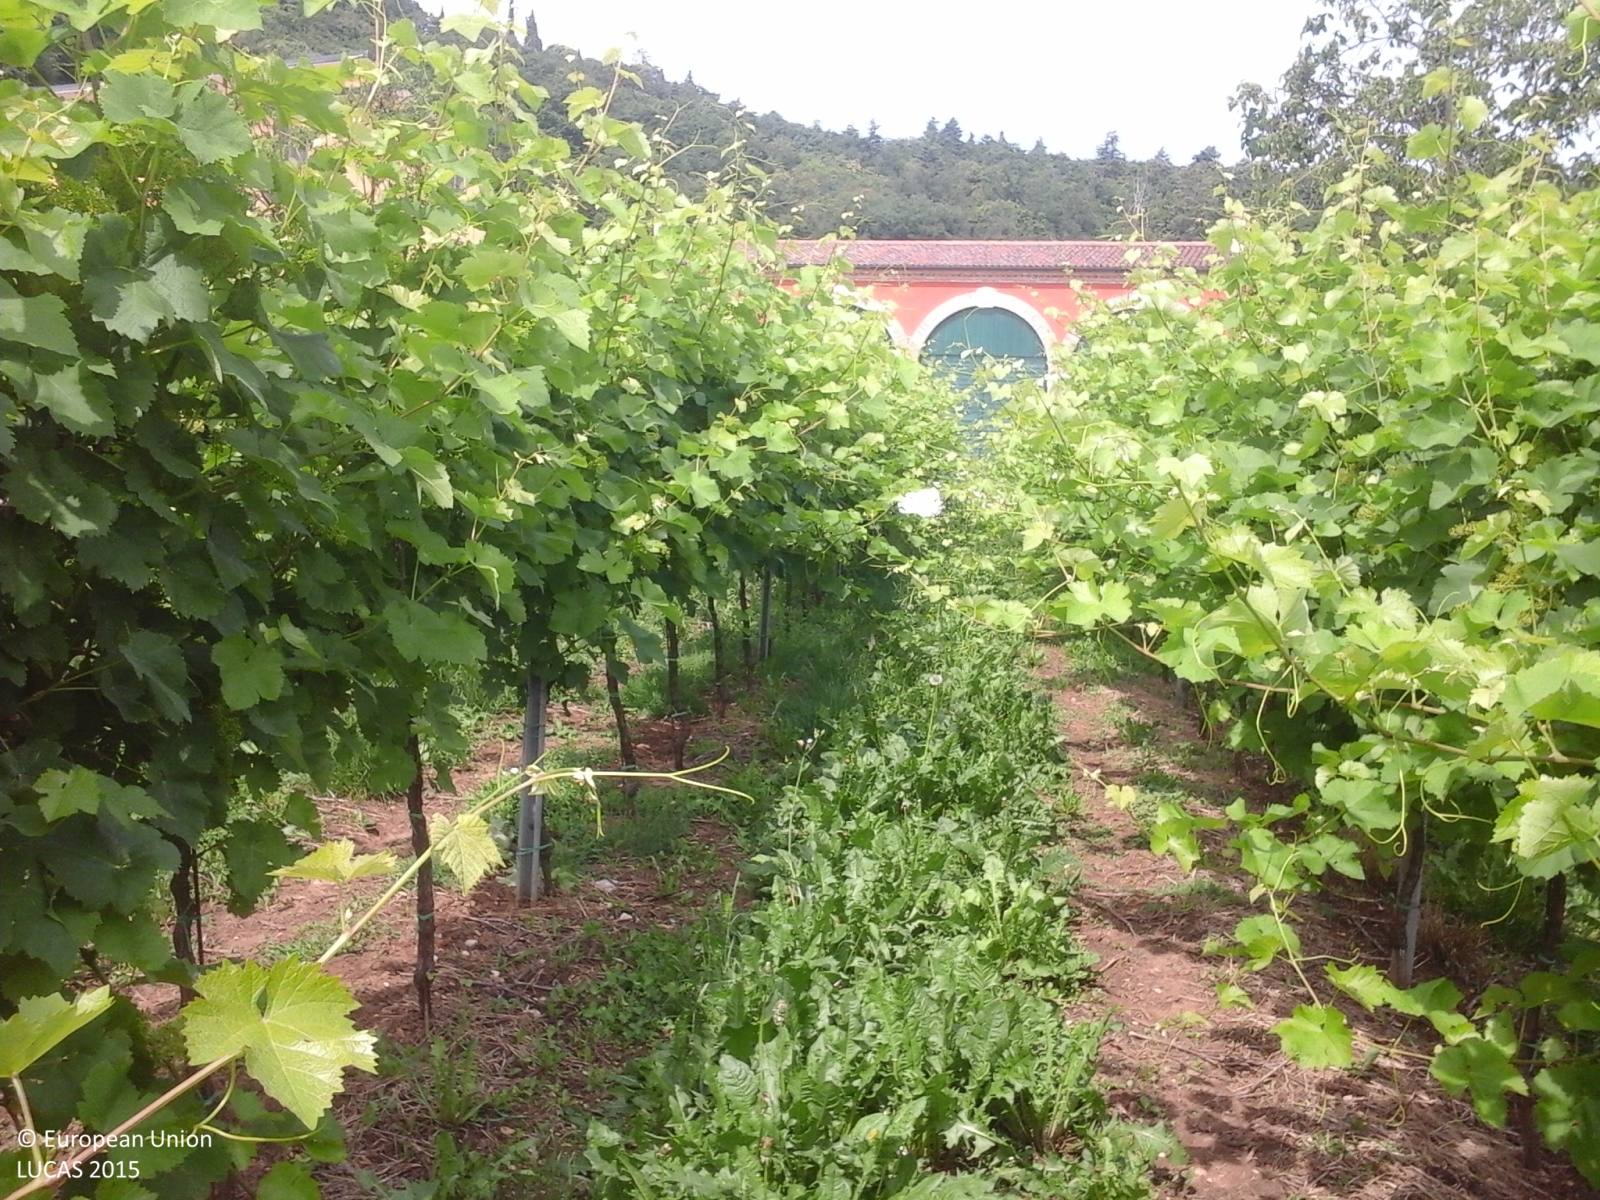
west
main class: Cropland
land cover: Vineyards
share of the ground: > 75 %
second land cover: Grassland without tree/shrub cover
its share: 50 - 75 %
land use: Agriculture (excluding fallow land and kitchen gardens)
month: May
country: IT
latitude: 45.4026
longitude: 11.5687
